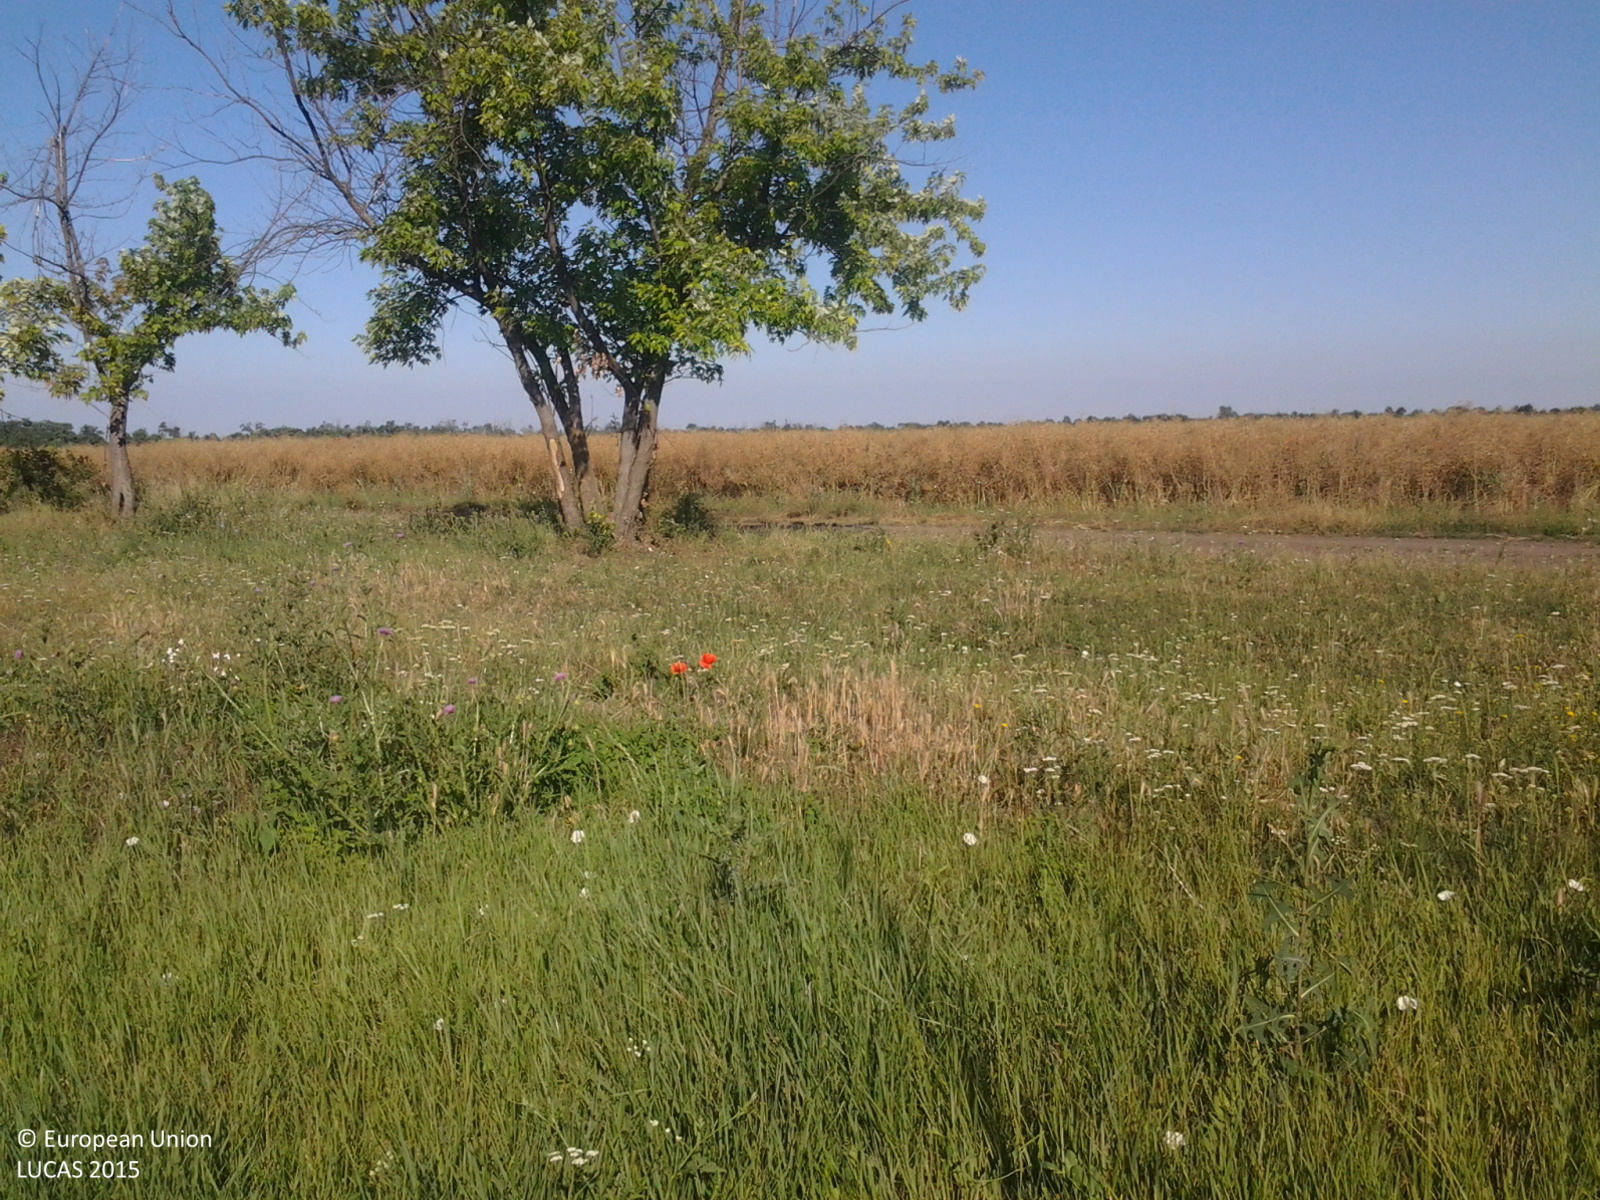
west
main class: Woodland
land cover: Broadleaved woodland
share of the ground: 10 - 25 %
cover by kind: herbaceous plants 75 %, broadleaved forest trees 15 %, shrubs 10 %
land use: Forestry
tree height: > 5 m
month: July
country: HU
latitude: 47.0702
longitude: 20.4714
